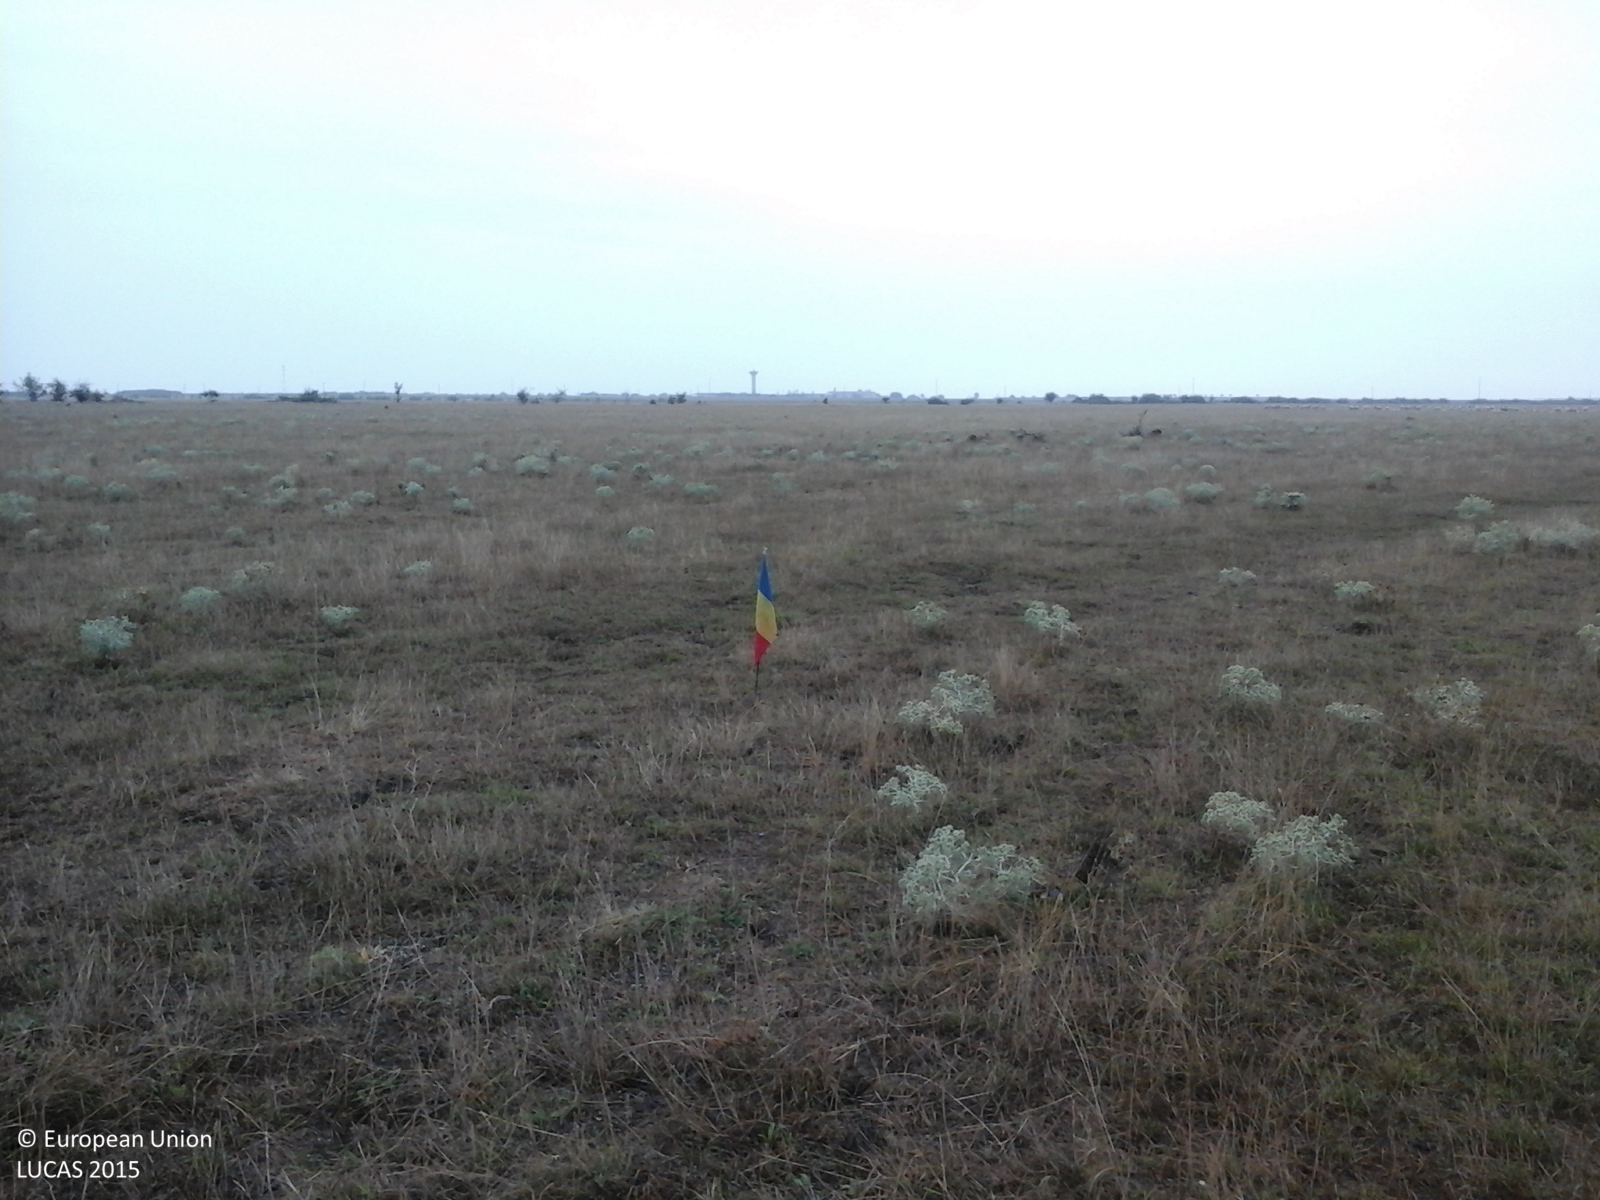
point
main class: Grassland
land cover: Spontaneously vegetated surfaces
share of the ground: > 75 %
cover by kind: herbaceous plants 100 %
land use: Fallow land
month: August
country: RO
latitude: 45.4639
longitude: 21.4266
